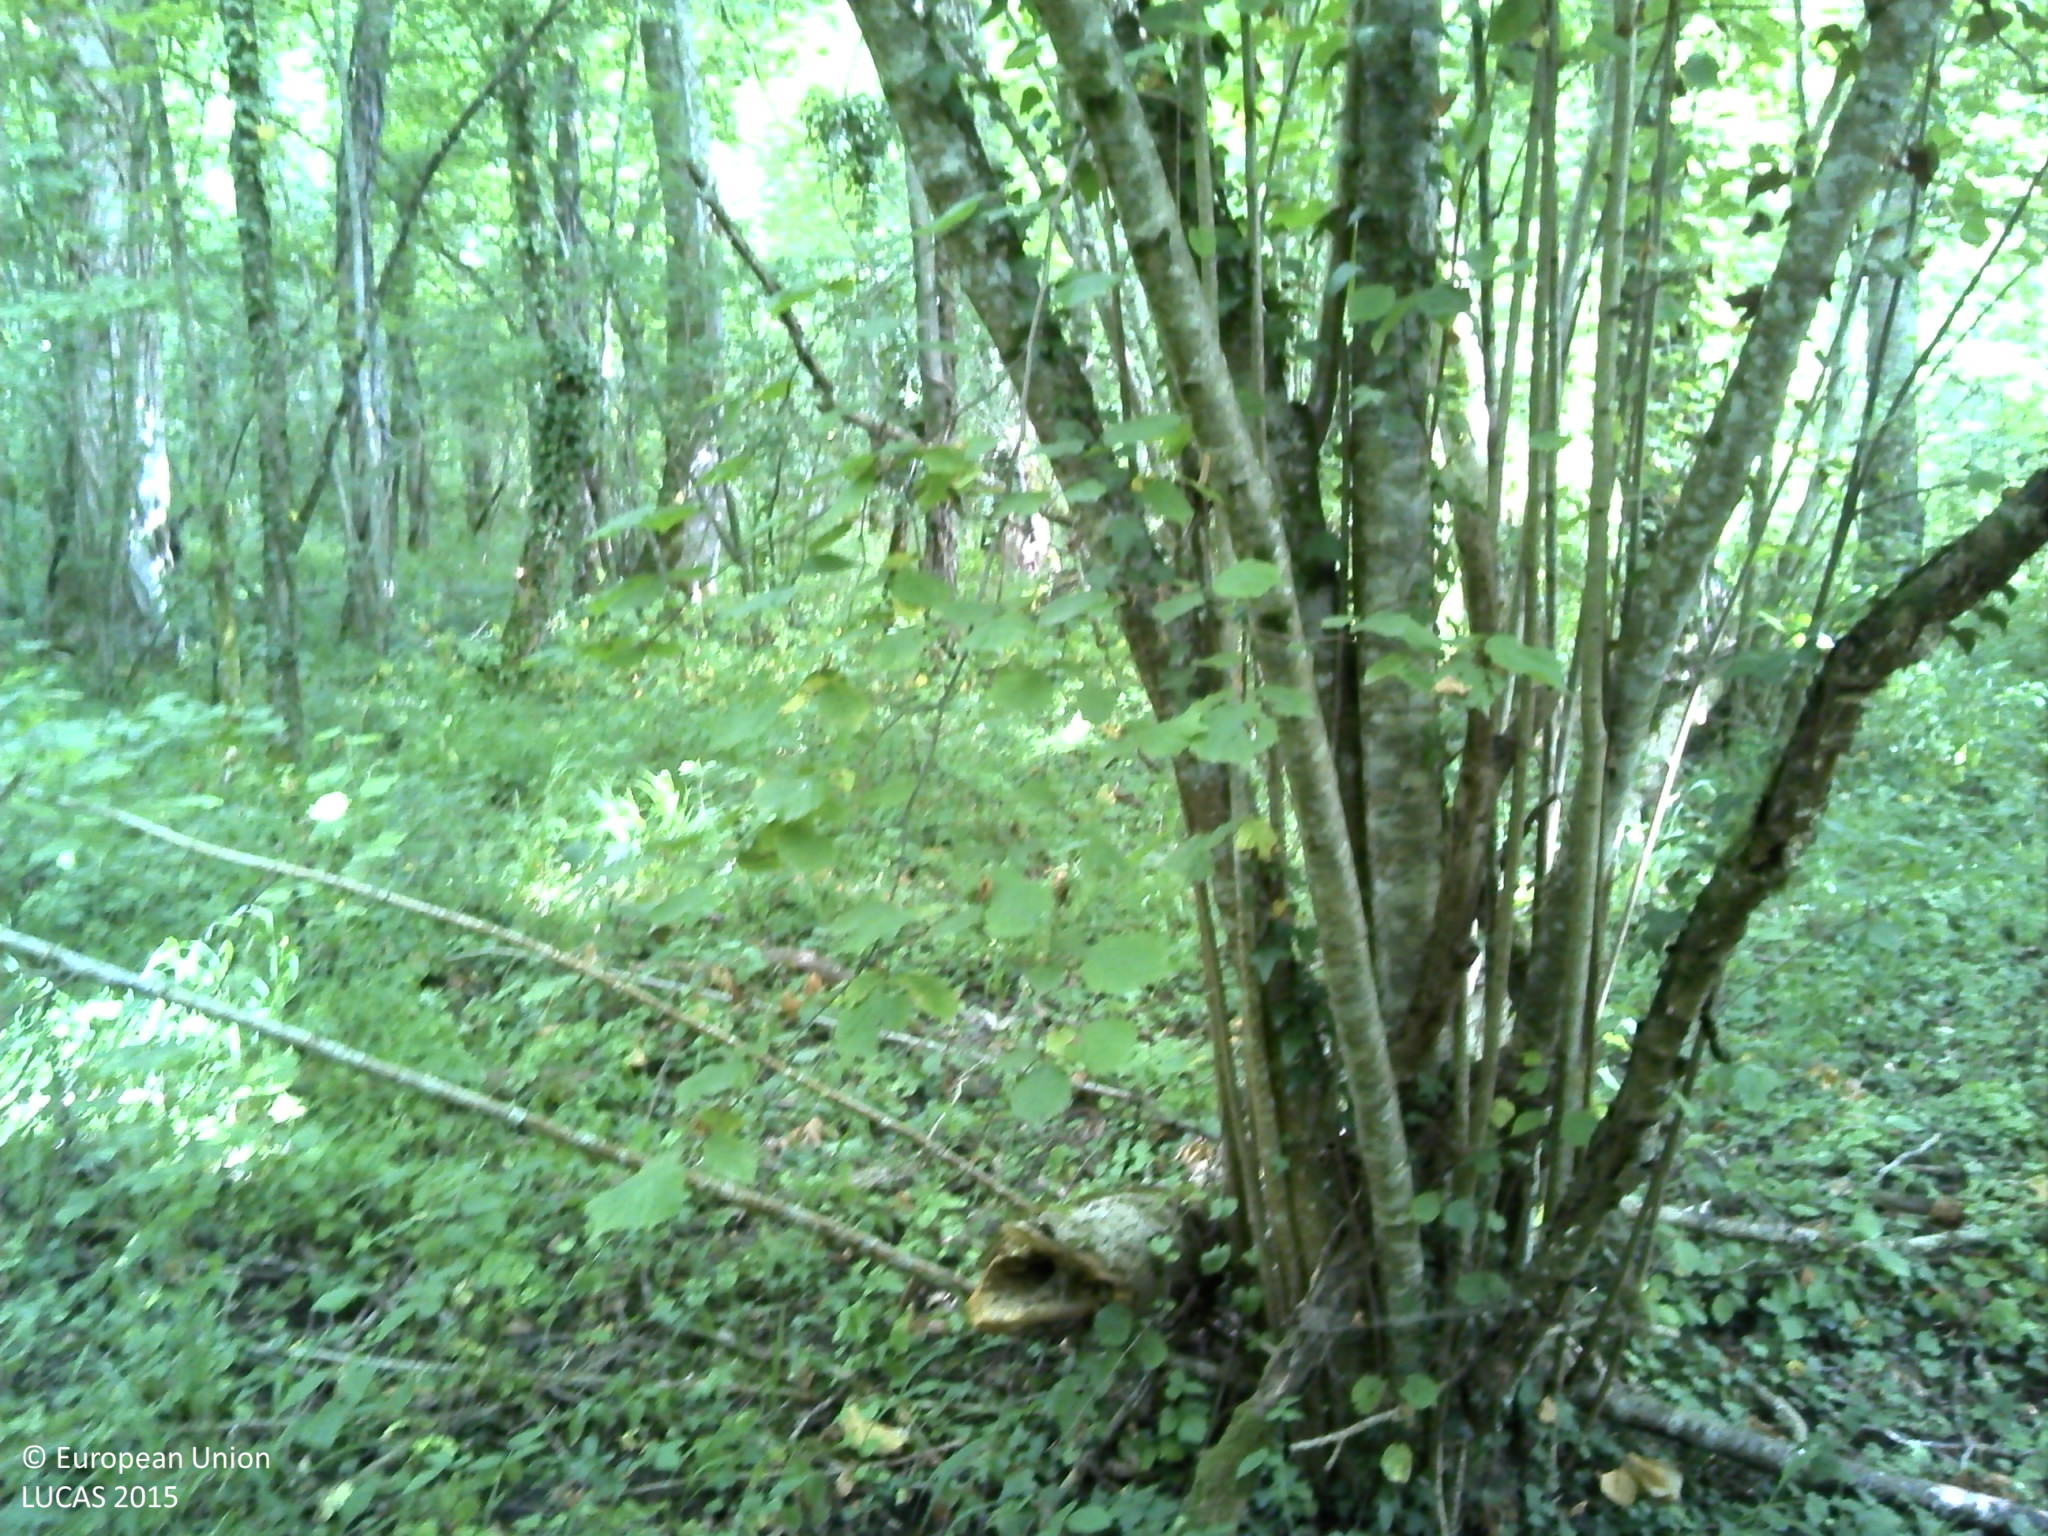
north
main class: Woodland
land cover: Broadleaved woodland
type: acidophilous oak and oak-birch forest
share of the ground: > 75 %
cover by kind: broadleaved forest trees 100 %
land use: Forestry
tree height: > 5 m
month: July
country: FR
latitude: 48.3242
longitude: 6.3185
